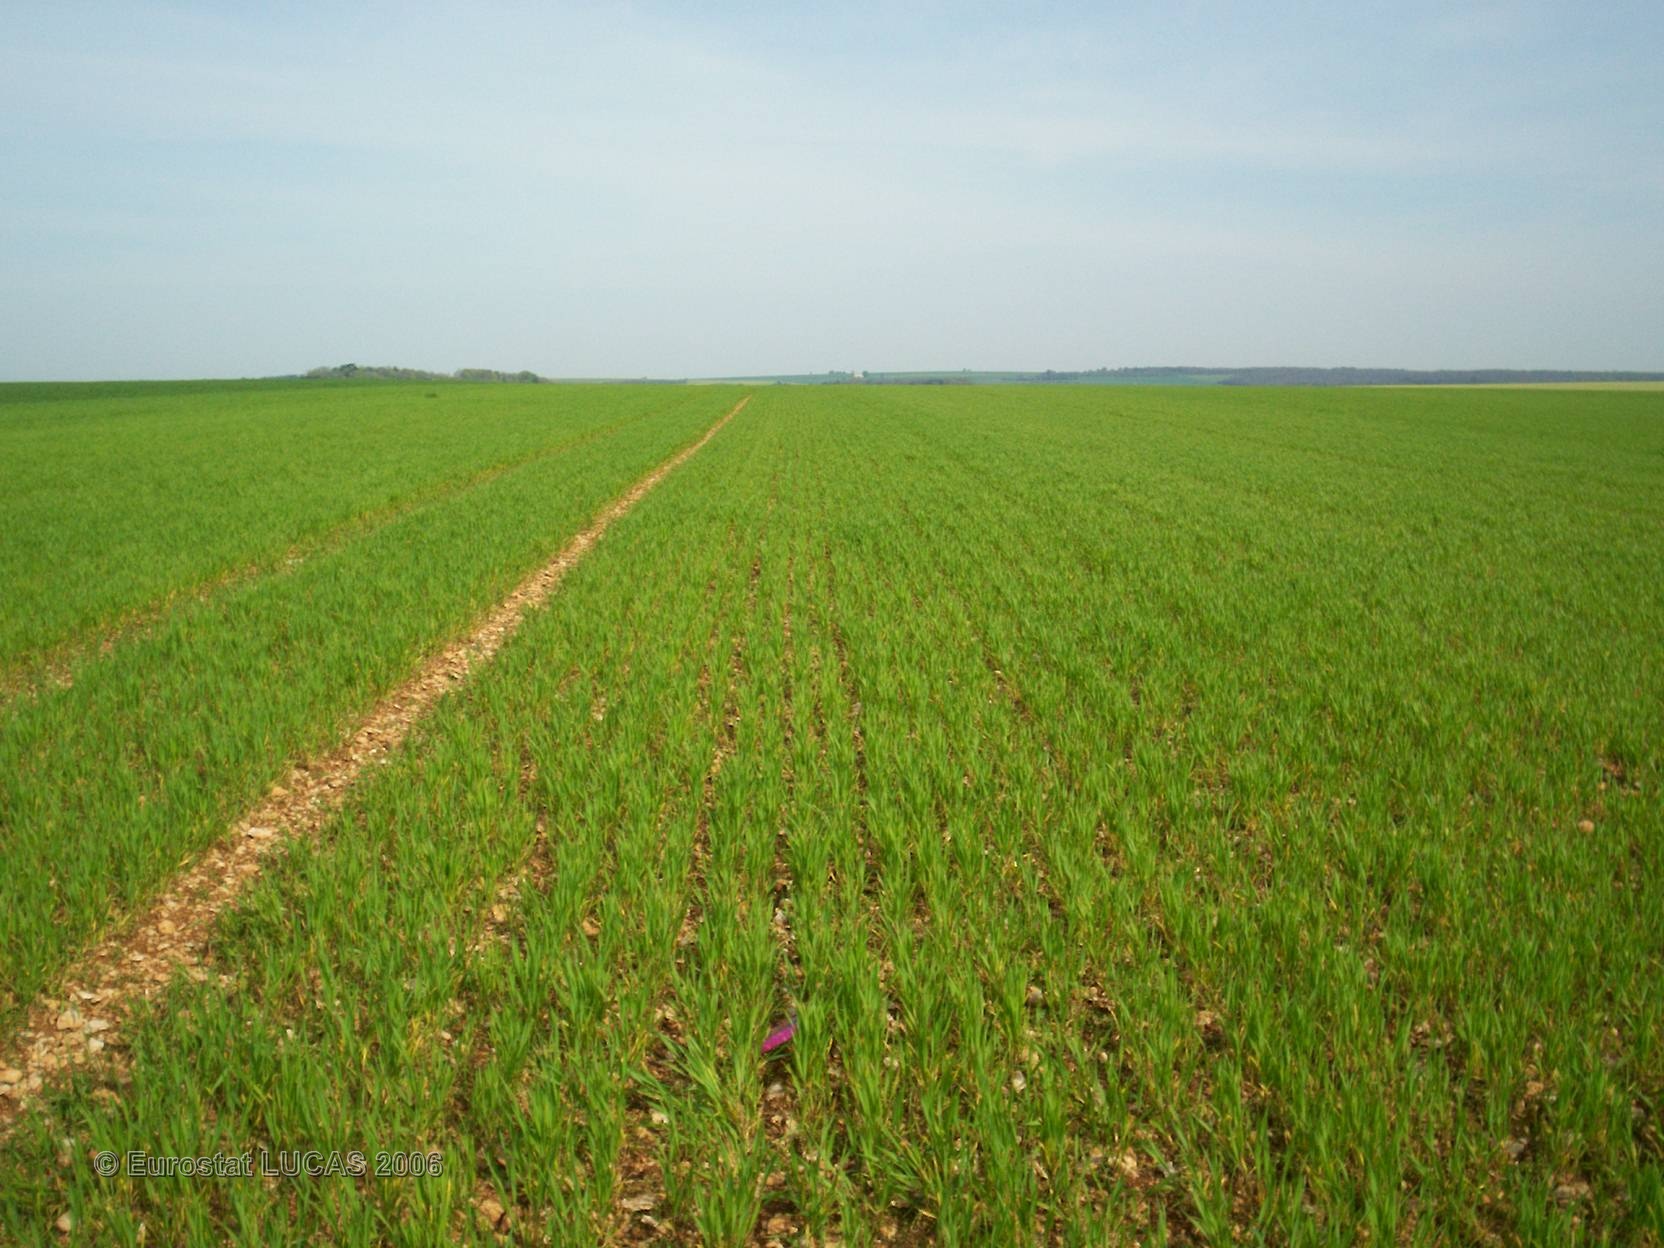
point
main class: Cropland
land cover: Common wheat
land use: Agriculture (excluding fallow land and kitchen gardens)
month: May
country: FR
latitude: 47.5650
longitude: 4.5362
